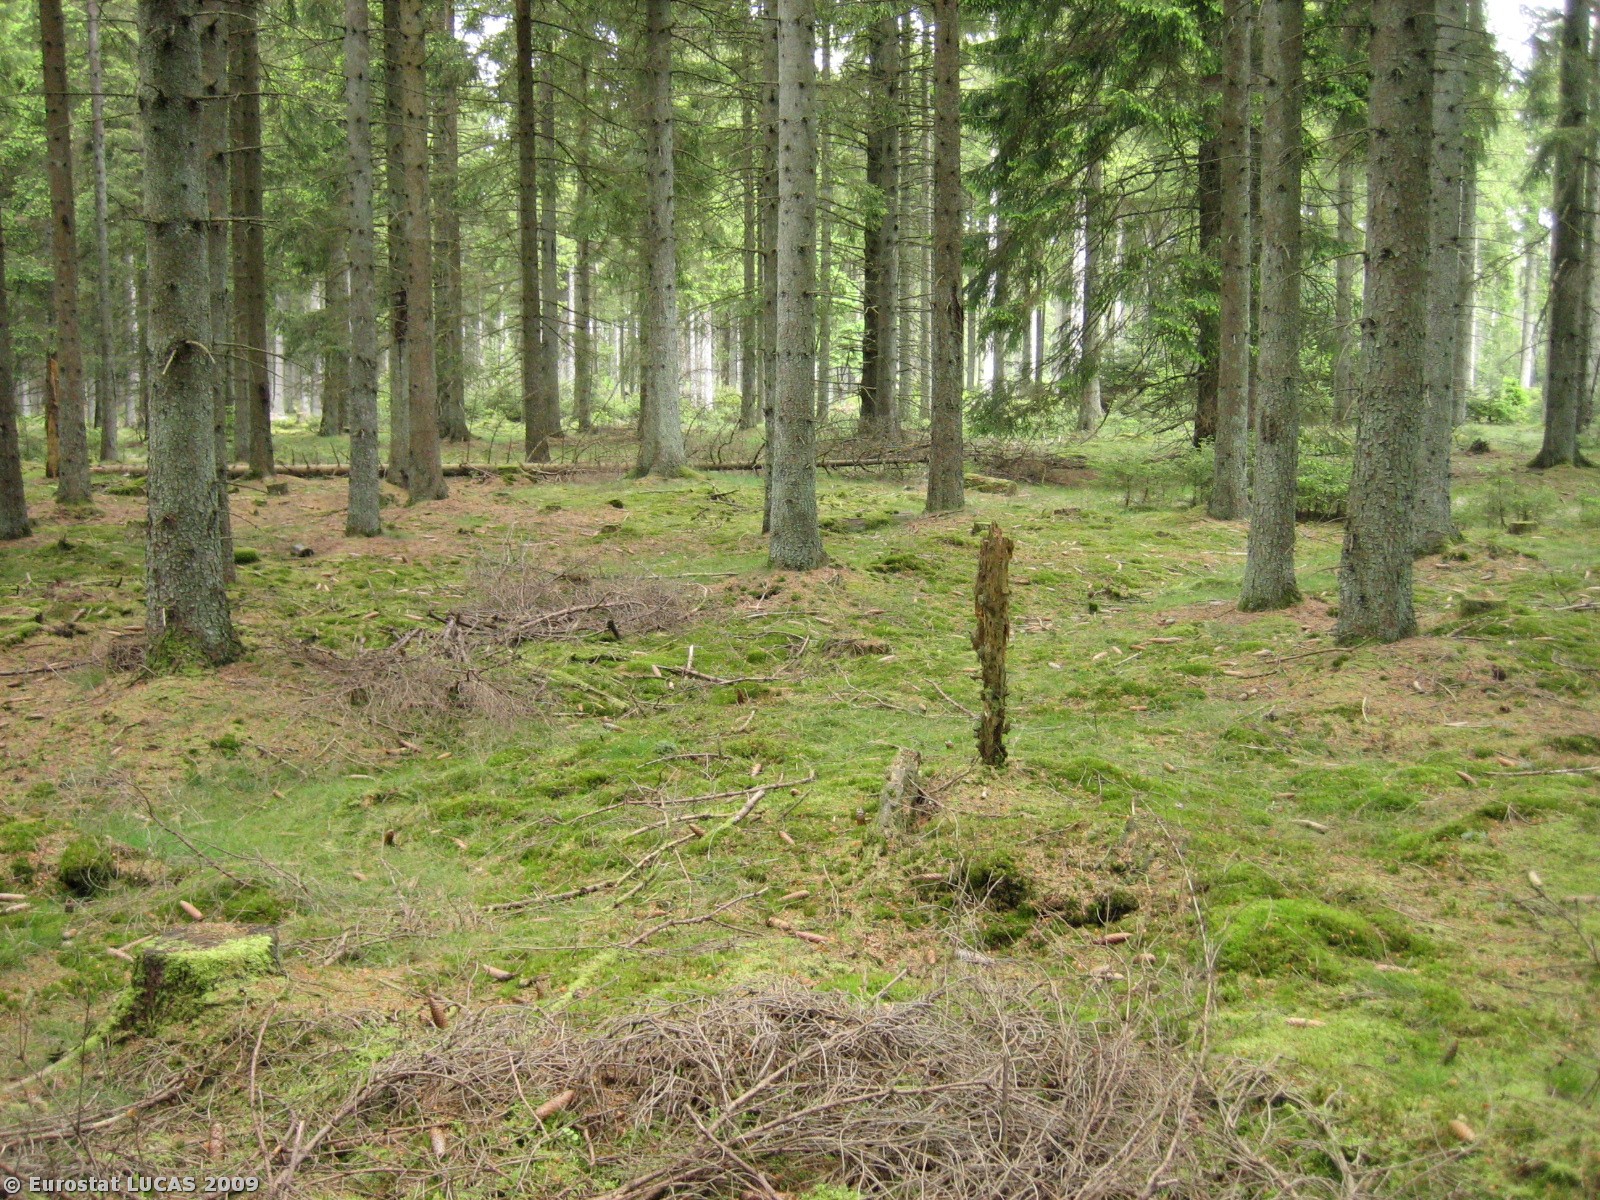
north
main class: Woodland
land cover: Coniferous woodland
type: hemiboreal forest and nemoral coniferous forest and mixed broadleaved-coniferous forest
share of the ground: 50 - 75 %
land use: Forestry
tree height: > 5 m
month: May
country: DK
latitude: 56.0780
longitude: 9.3099
